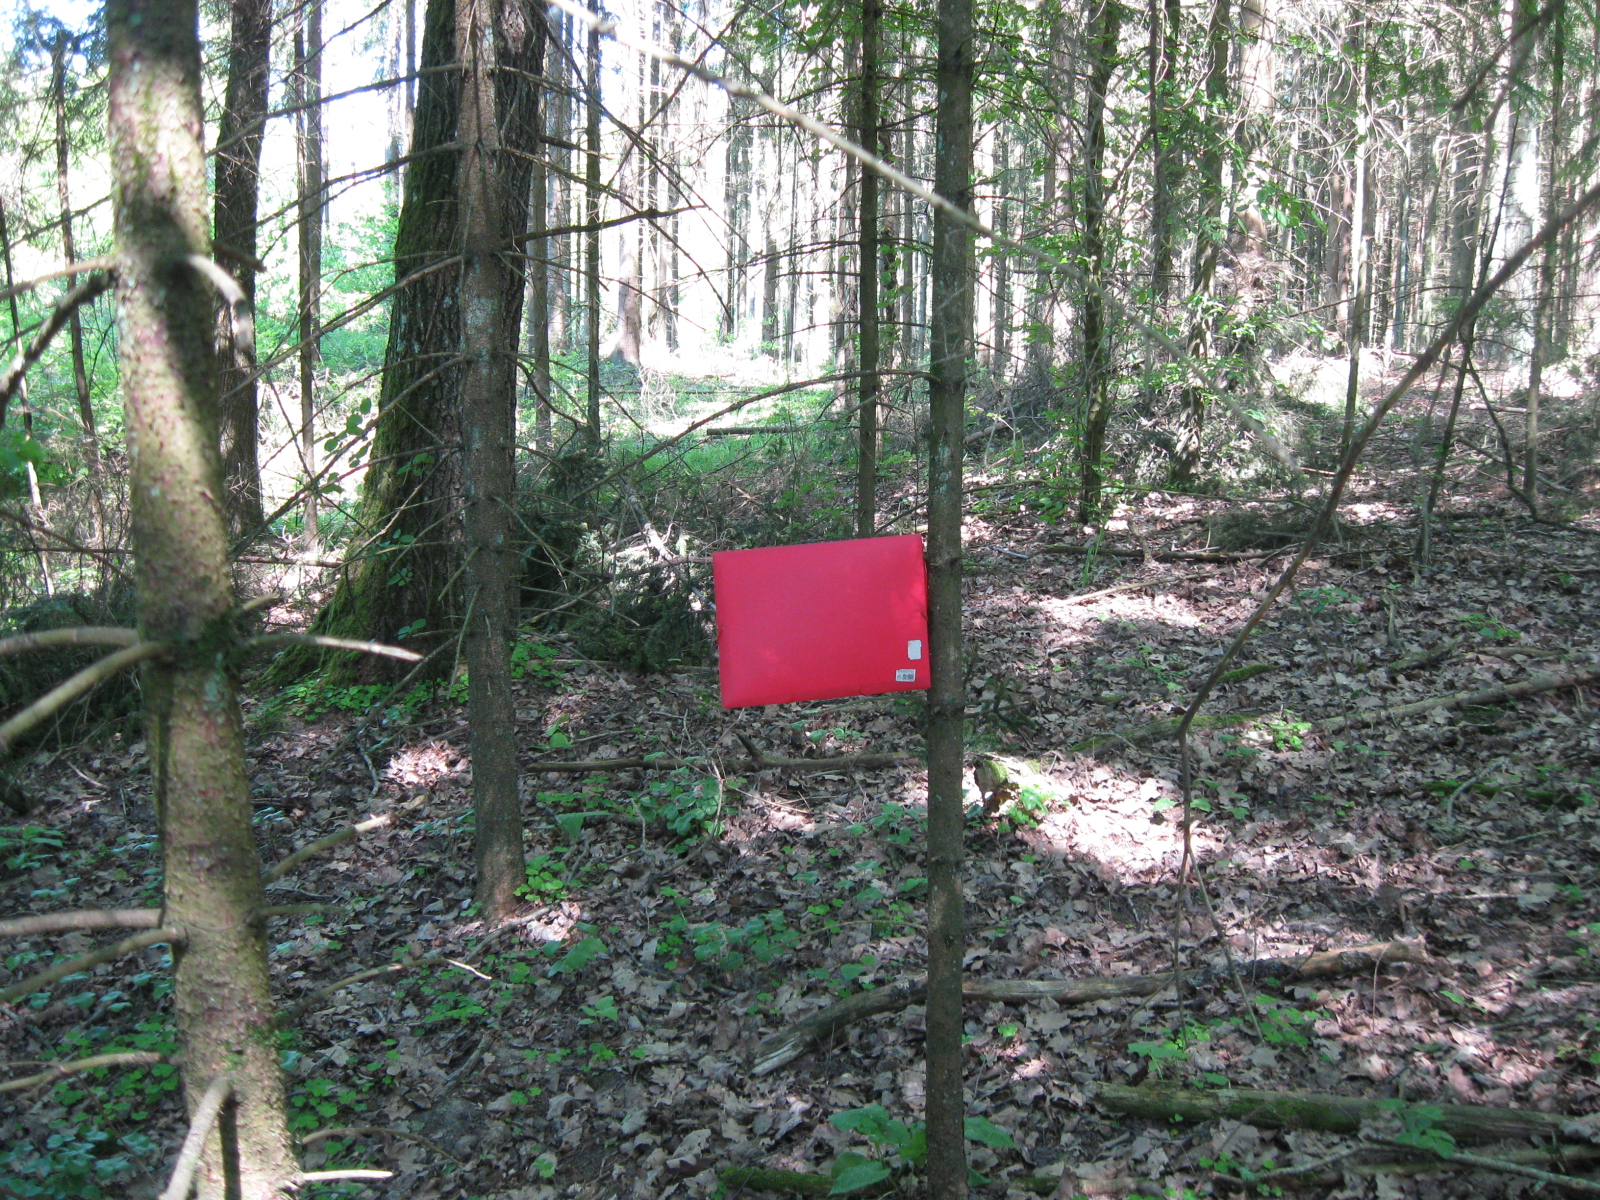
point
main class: Woodland
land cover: Spruce dominated mixed woodland
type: hemiboreal forest and nemoral coniferous forest and mixed broadleaved-coniferous forest
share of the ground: > 75 %
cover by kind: coniferous forest trees 55 %, broadleaved forest trees 45 %
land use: Forestry
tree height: > 5 m
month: June
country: LT
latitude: 54.1091
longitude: 23.5906
